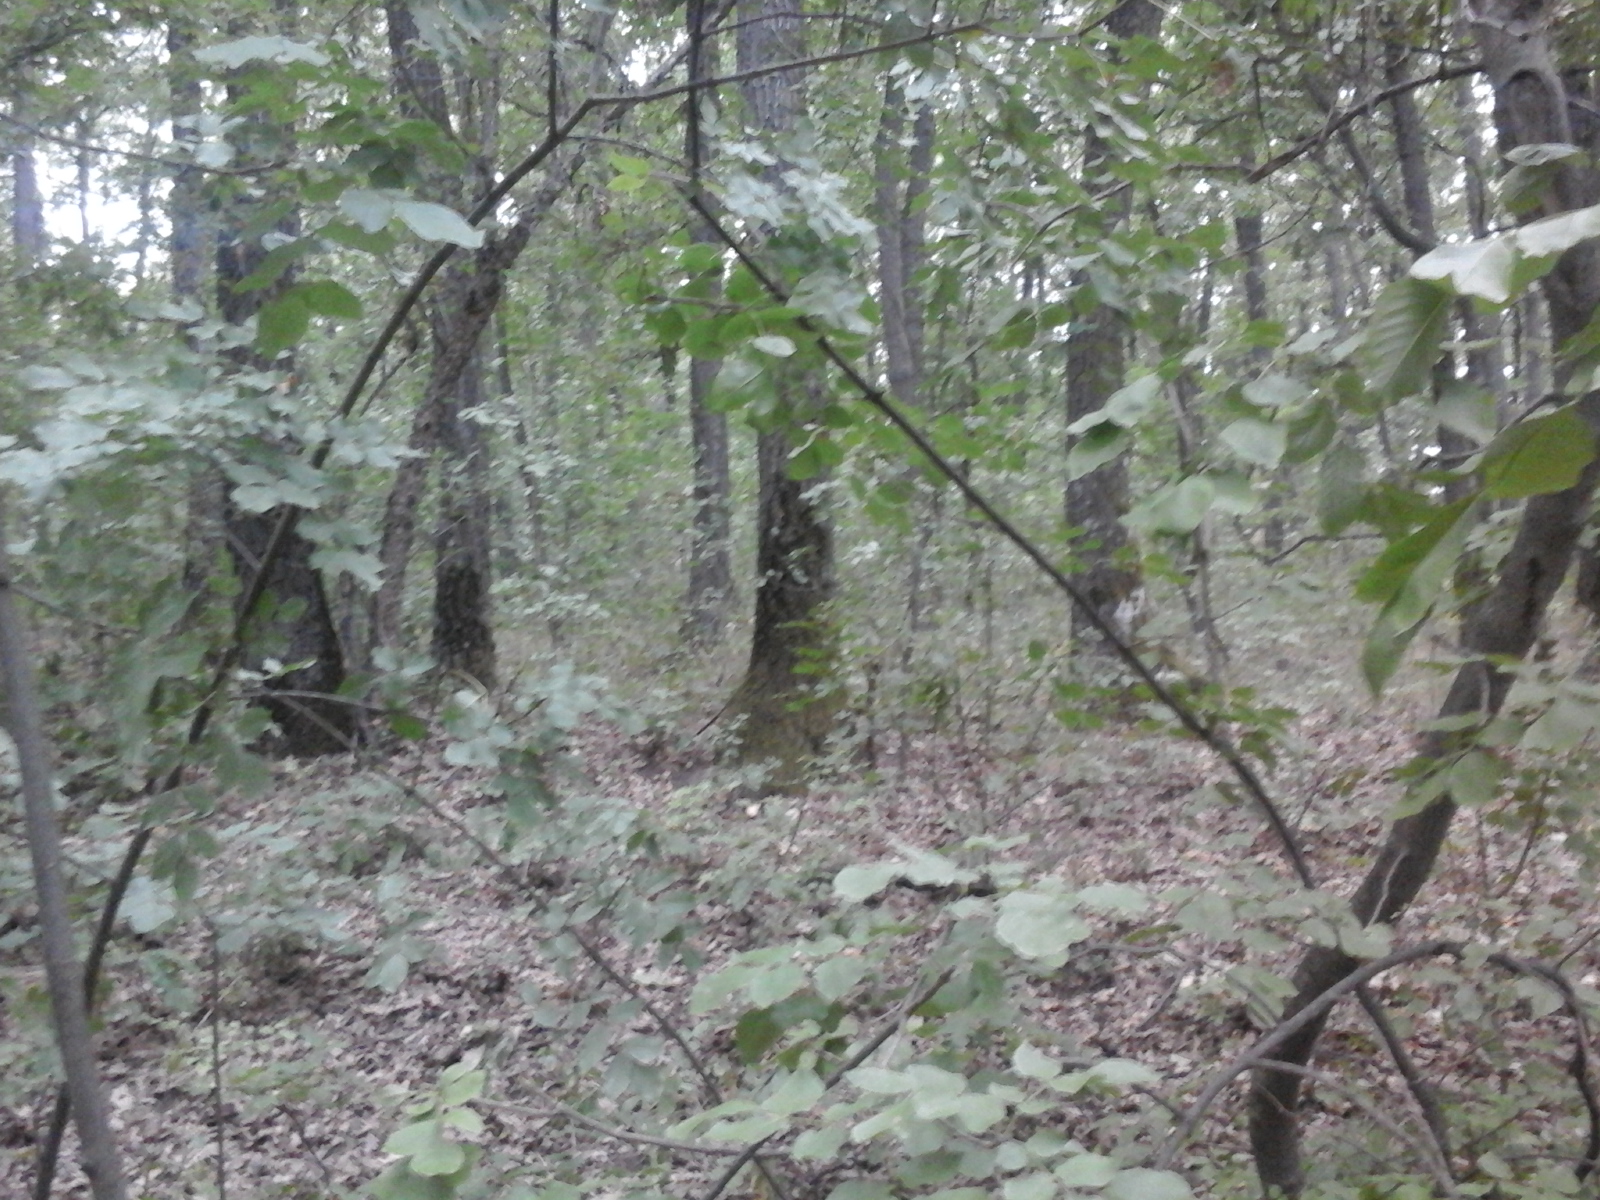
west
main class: Woodland
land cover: Broadleaved woodland
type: acidophilous oak and oak-birch forest
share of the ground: > 75 %
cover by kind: broadleaved forest trees 100 %
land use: Forestry
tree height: > 5 m
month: August
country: RO
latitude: 44.6160
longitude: 23.3469
